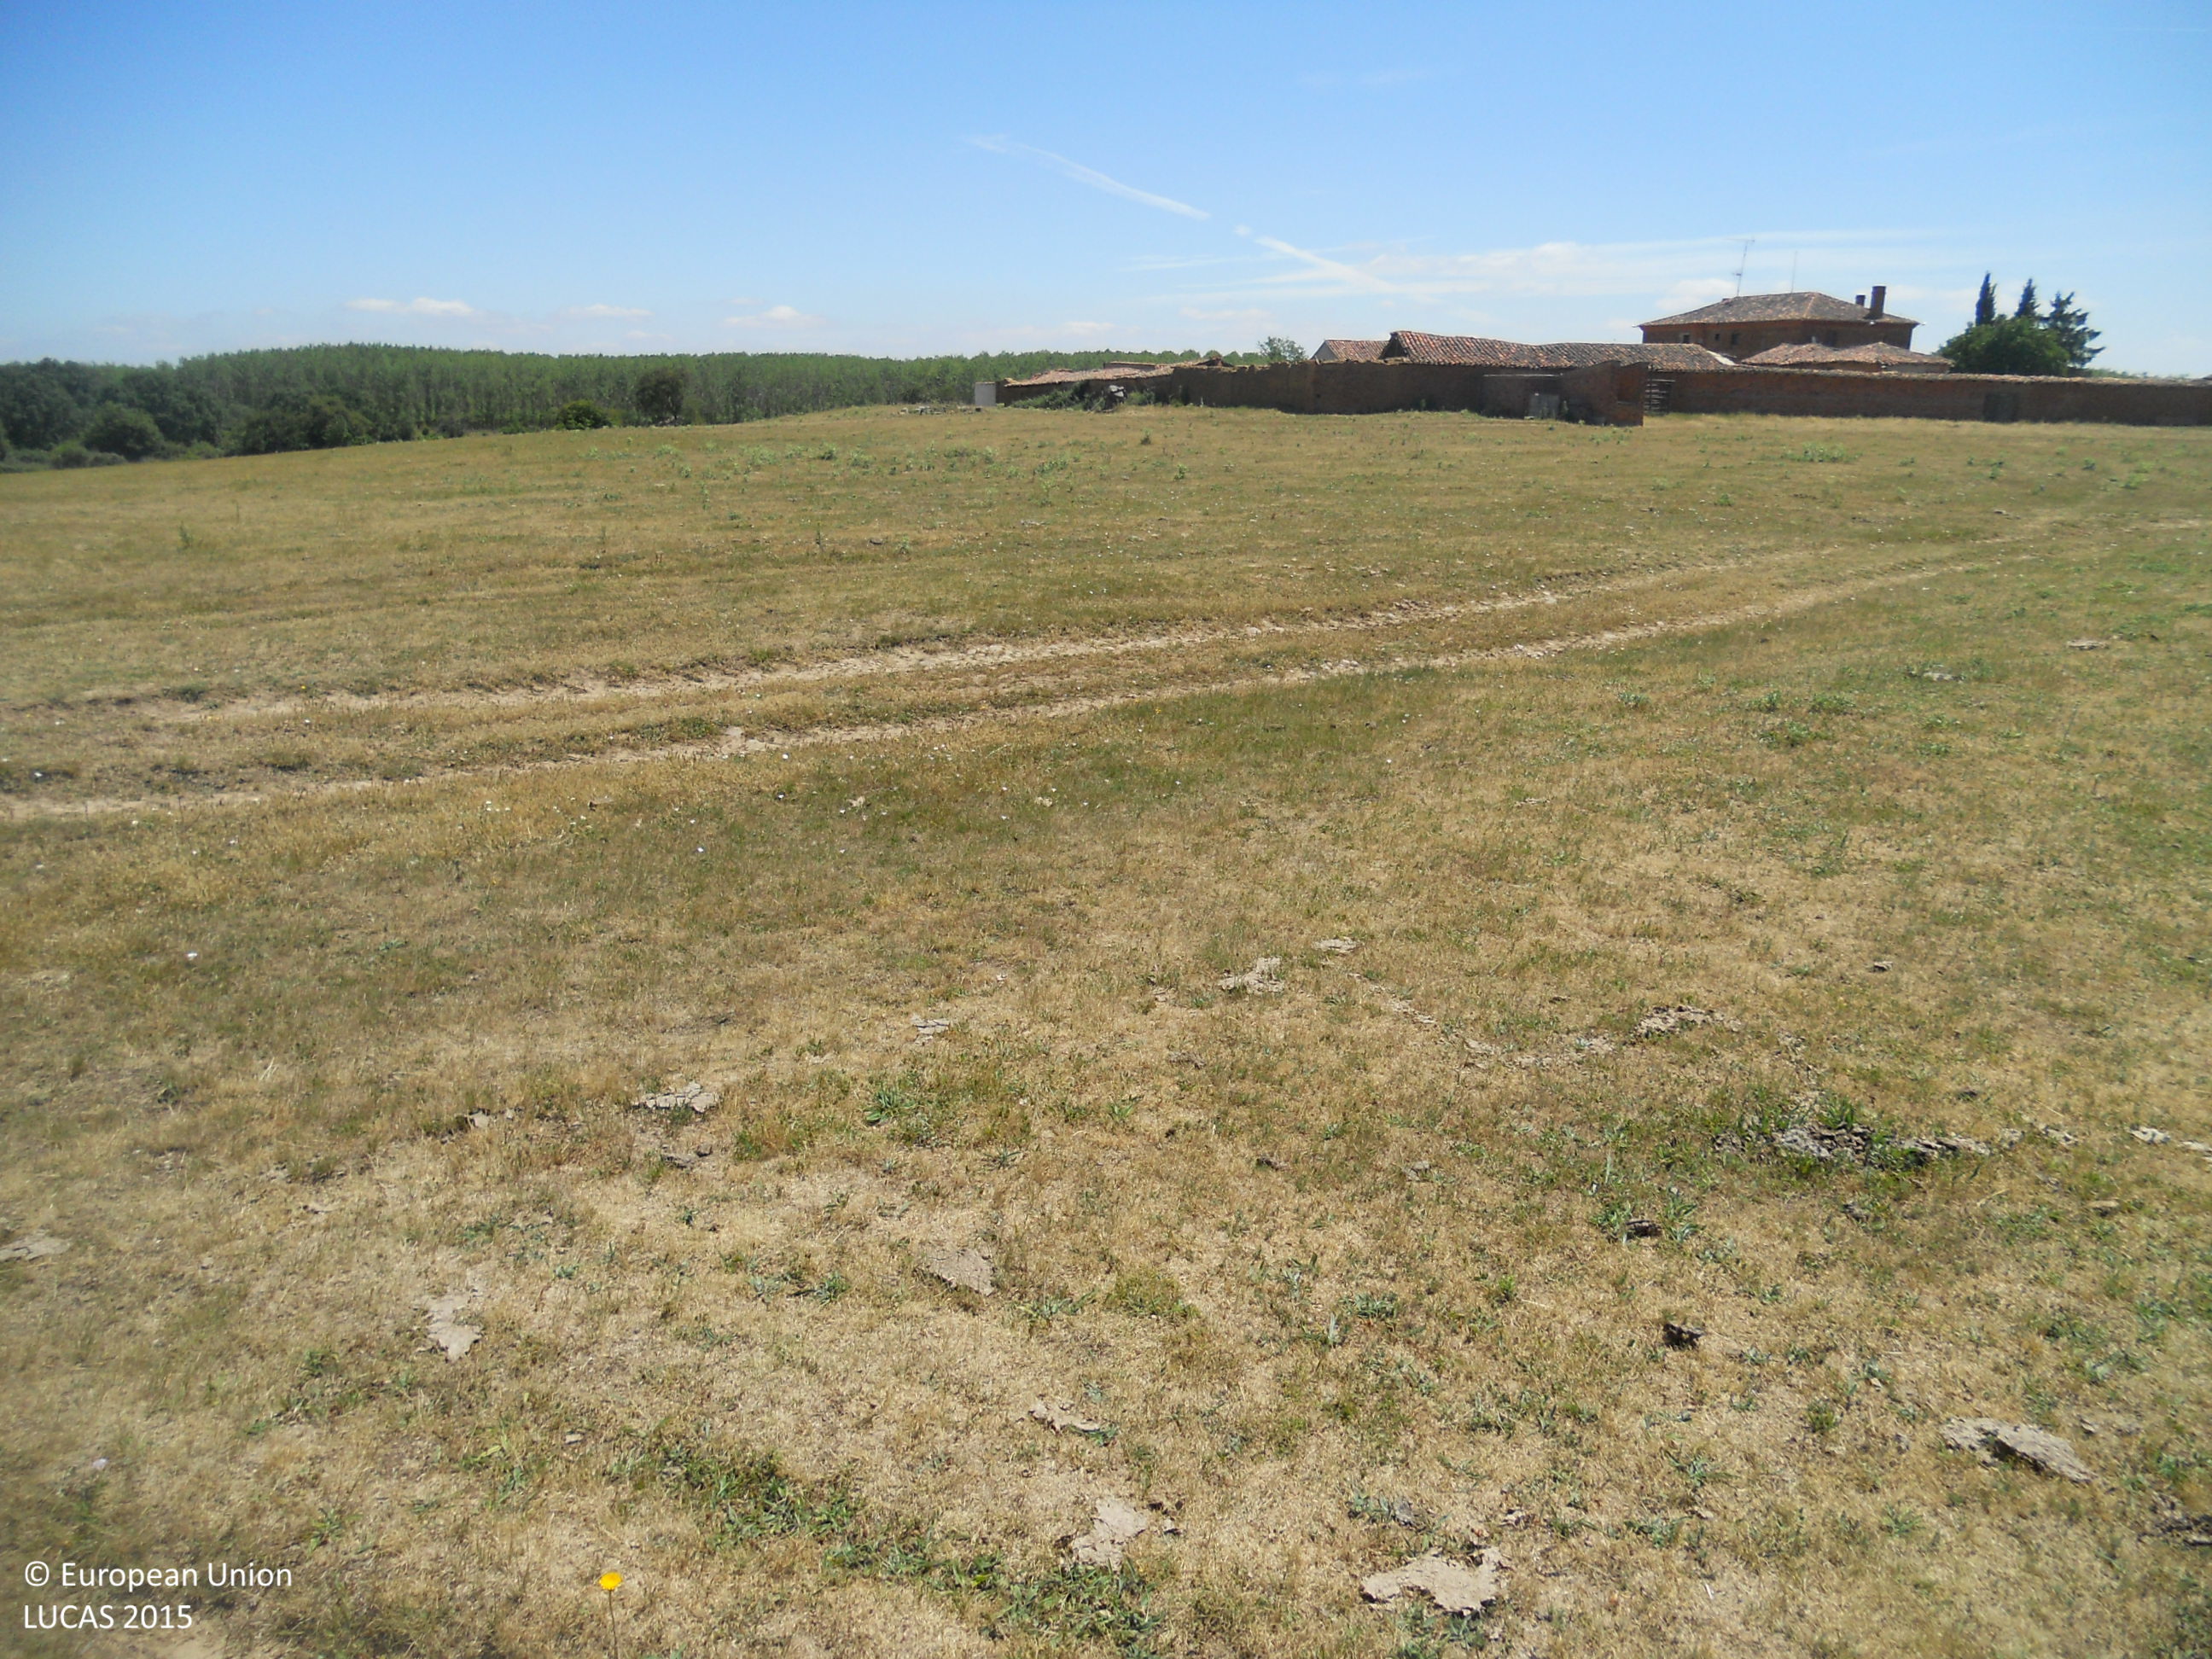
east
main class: Grassland
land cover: Grassland without tree/shrub cover
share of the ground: > 75 %
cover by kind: herbaceous plants 100 %
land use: Agriculture (excluding fallow land and kitchen gardens)
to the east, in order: Grassland without tree/shrub cover; Artificial constructions in urban areas; Grassland without tree/shrub cover; Single bushes/trees; Fences; Grassland without tree/shrub cover
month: June
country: ES
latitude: 42.3687
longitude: -4.7843
